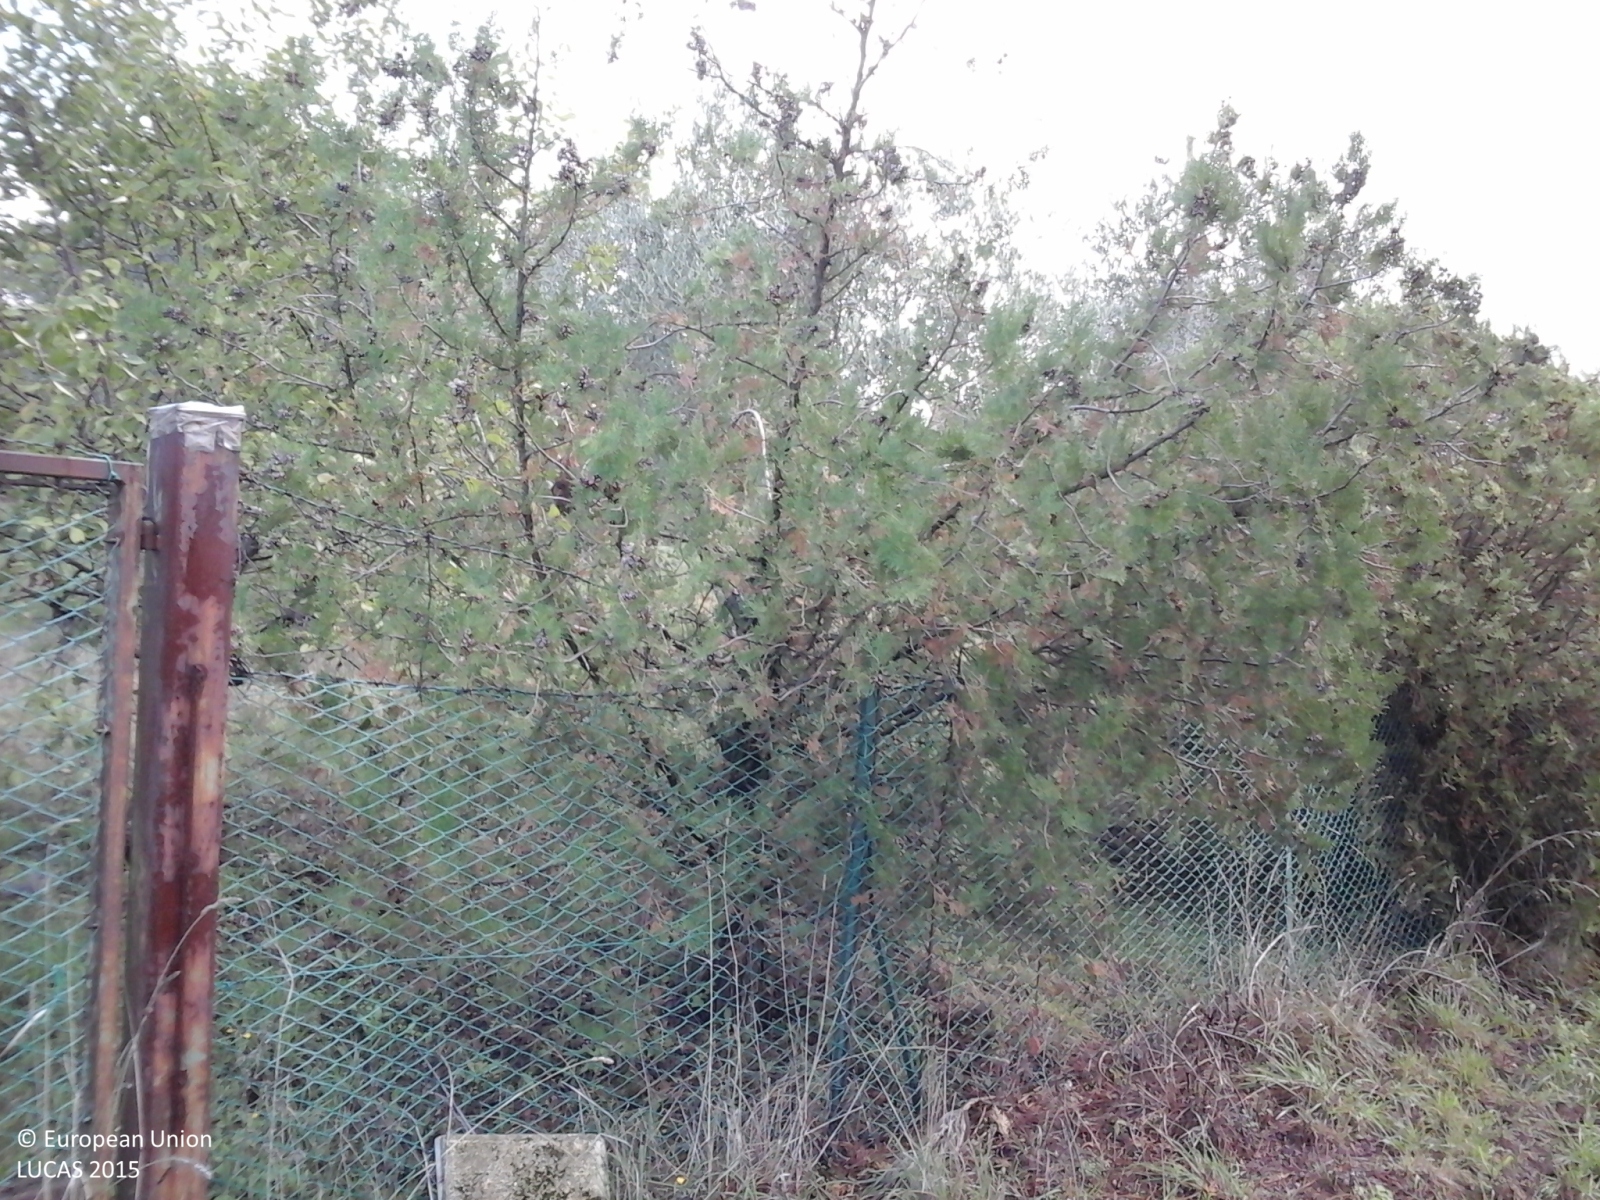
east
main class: Woodland
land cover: Pine dominated mixed woodland
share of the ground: > 75 %
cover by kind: coniferous forest trees 40 %, herbaceous plants 40 %, broadleaved forest trees 20 %
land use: Residential
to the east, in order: Pine dominated mixed woodland; Grassland with sparse tree/shrub cover; Managed hedges; Fences; Grass margins; Paved roads, cycling and walking lanes; Abandoned hedges; Electric lines; Durum wheat; Abandoned hedges; Electric lines; Ditches and canals; Paved roads, cycling and walking lanes; Ditches and canals; Lines of trees; Electric lines; Durum wheat; Single bushes/trees; Durum wheat
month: October
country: IT
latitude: 43.5744
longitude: 13.3476
